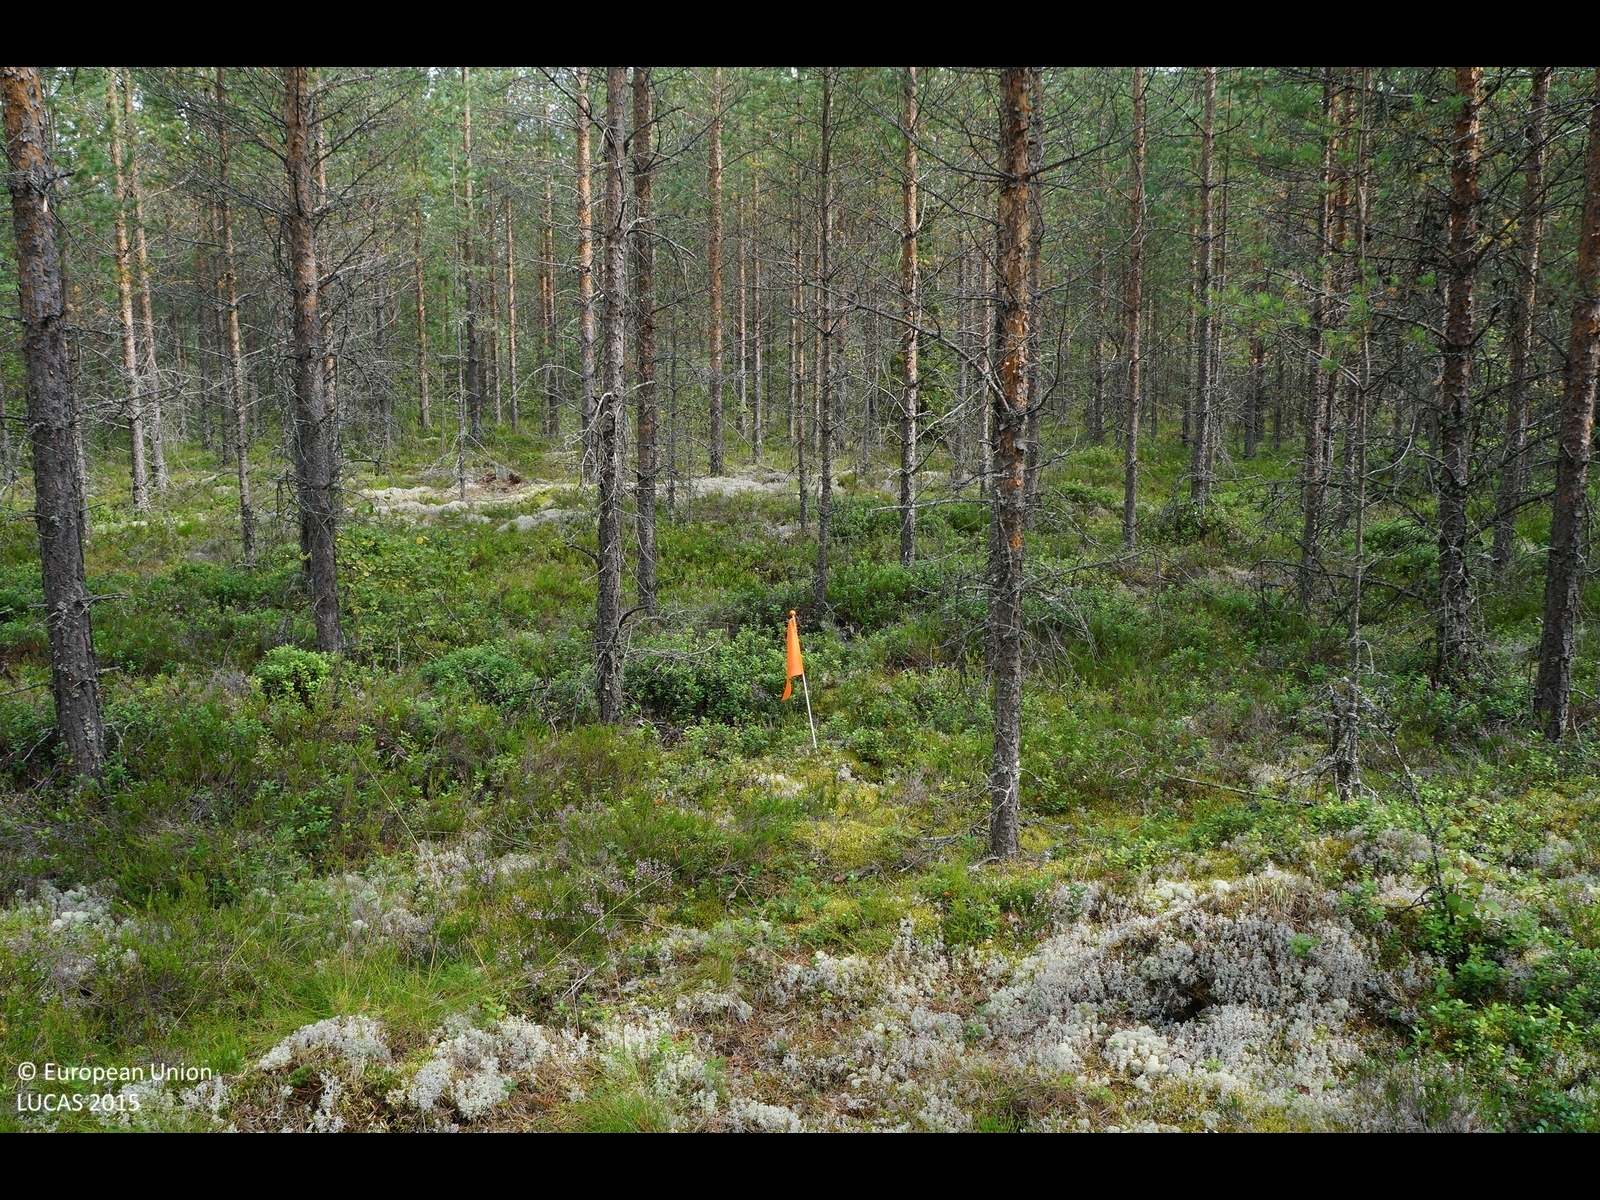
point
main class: Woodland
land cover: Pine dominated coniferous woodland
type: boreal forest
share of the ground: 50 - 75 %
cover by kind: coniferous forest trees 60 %, shrubs 20 %, lichens and mosses 20 %
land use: Forestry
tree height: > 5 m
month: August
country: FI
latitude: 64.7932
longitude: 24.7382
